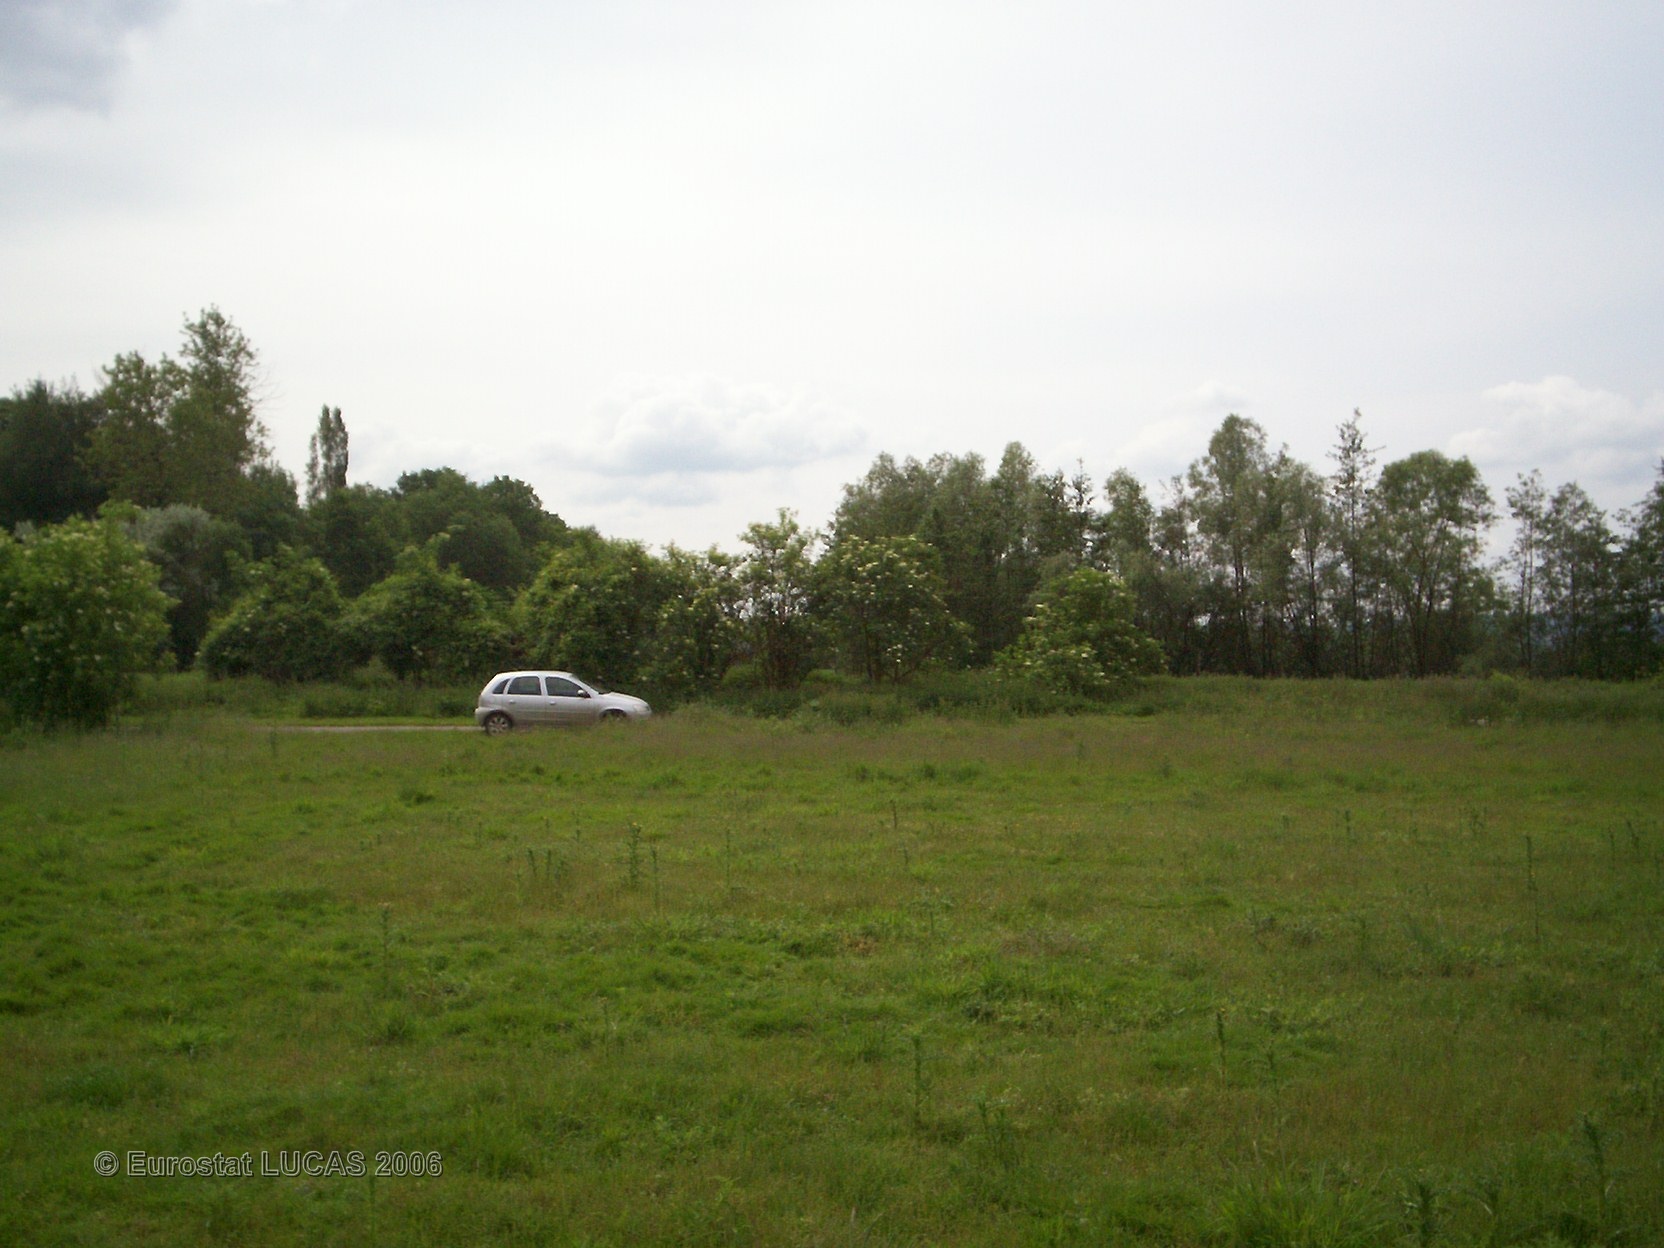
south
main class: Grassland
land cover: Grassland without tree/shrub cover
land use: Agriculture (excluding fallow land and kitchen gardens)
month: June
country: FR
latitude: 49.3349
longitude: 2.6817
